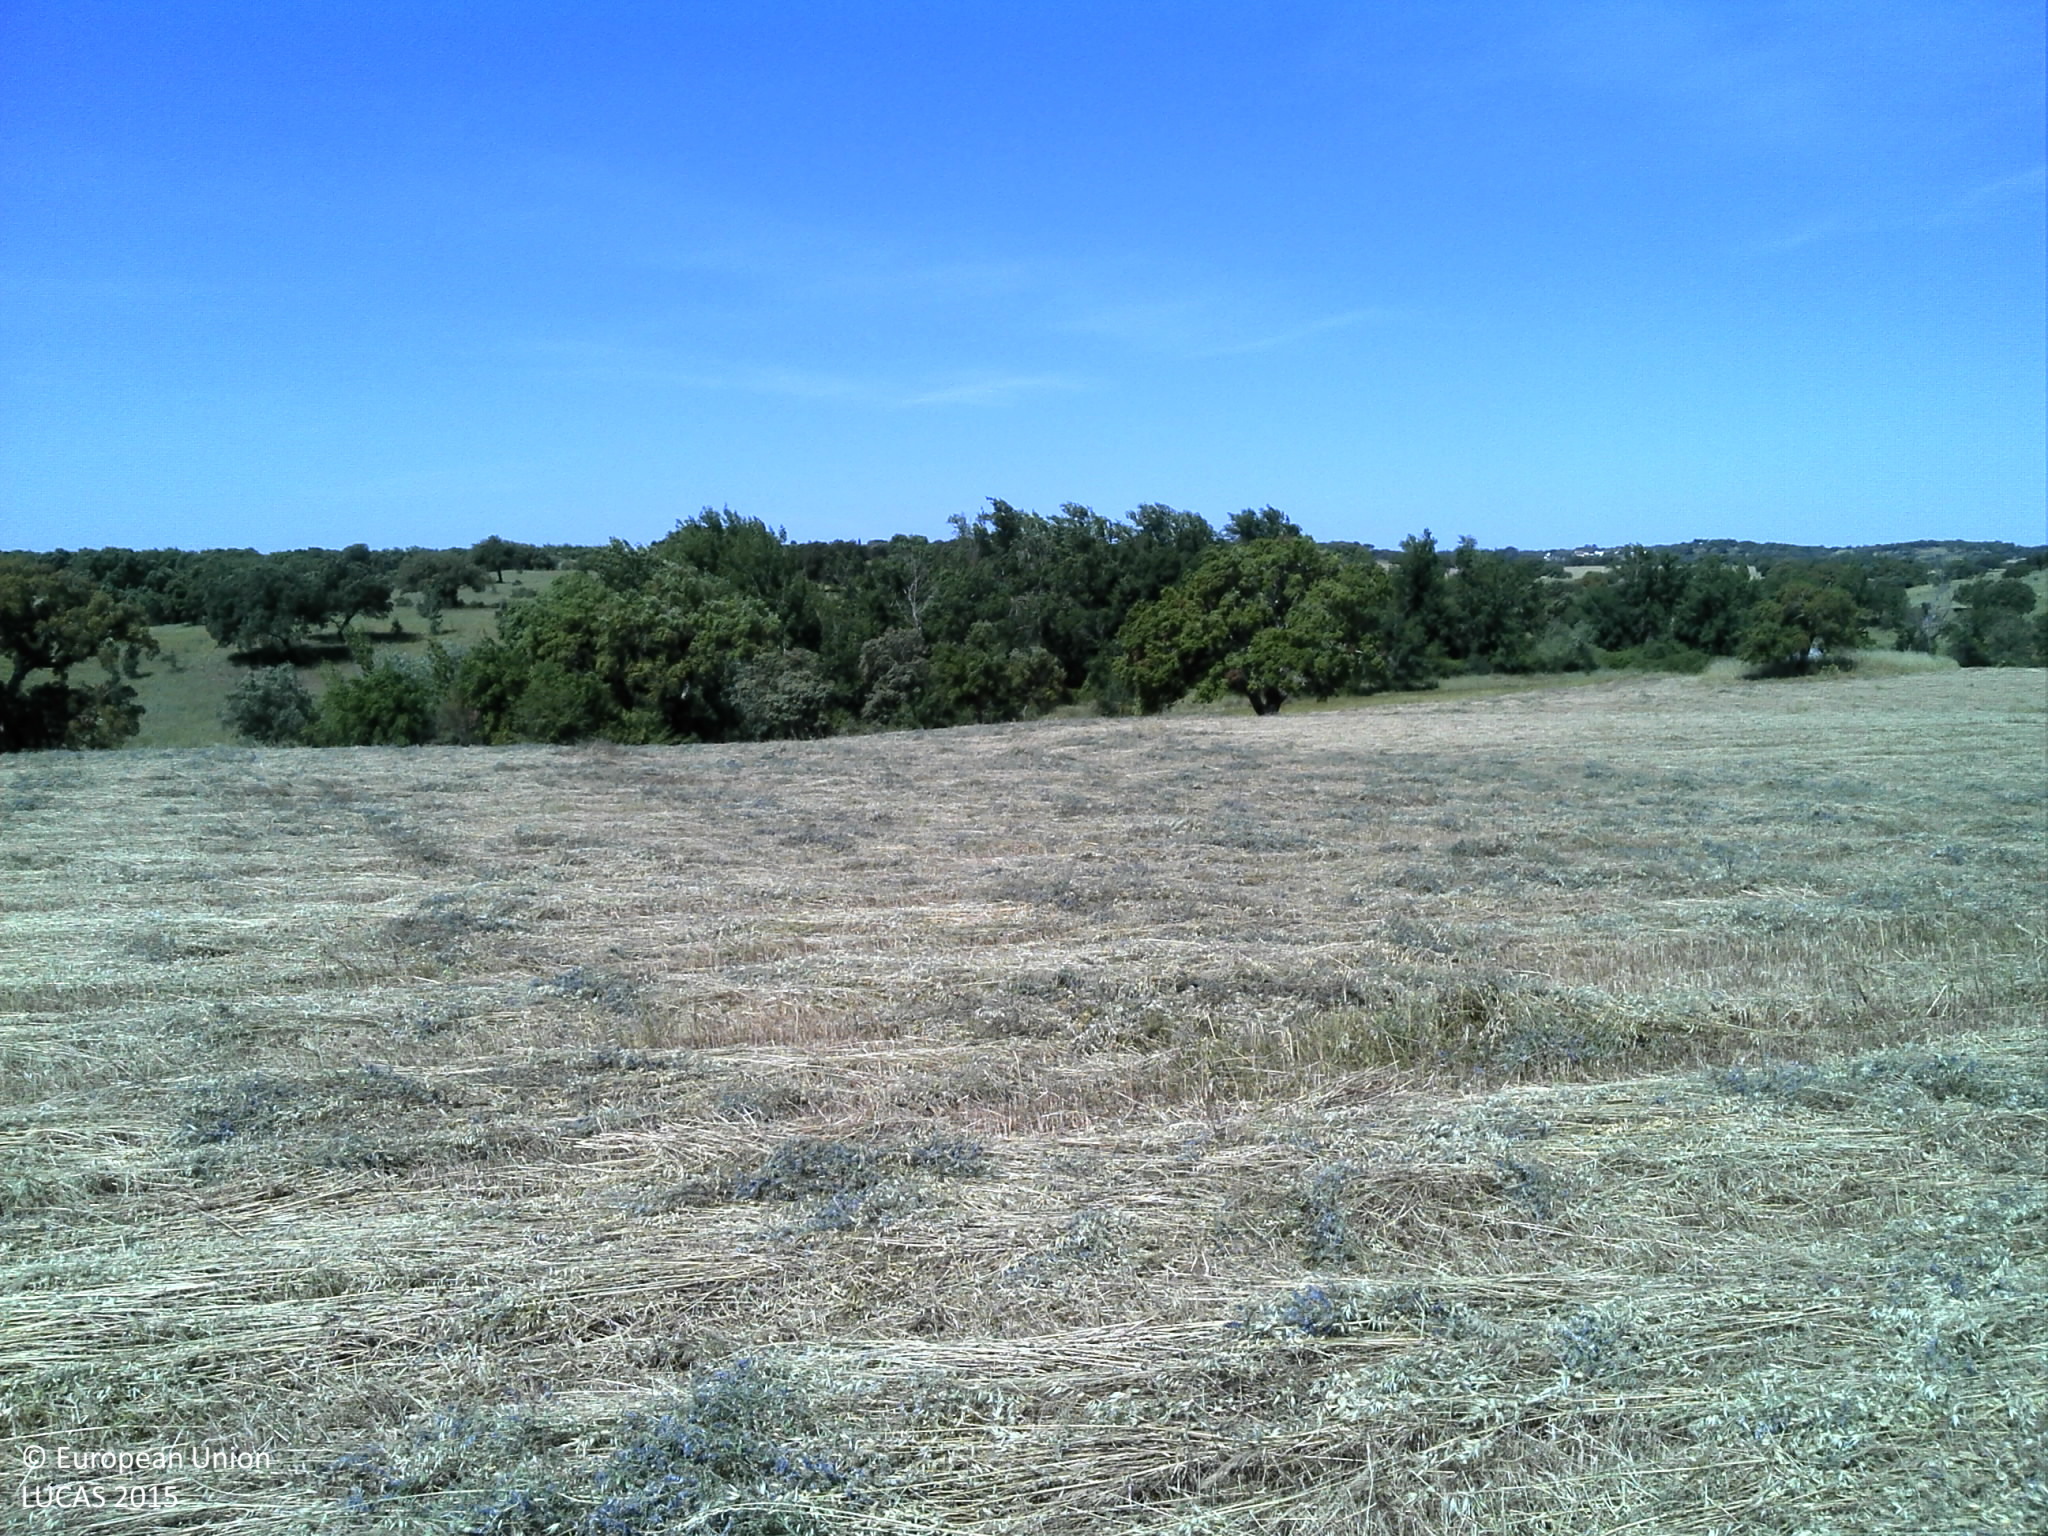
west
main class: Cropland
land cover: Temporary grasslands
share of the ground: > 75 %
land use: Agriculture (excluding fallow land and kitchen gardens)
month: May
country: PT
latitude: 39.1717
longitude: -7.8394
